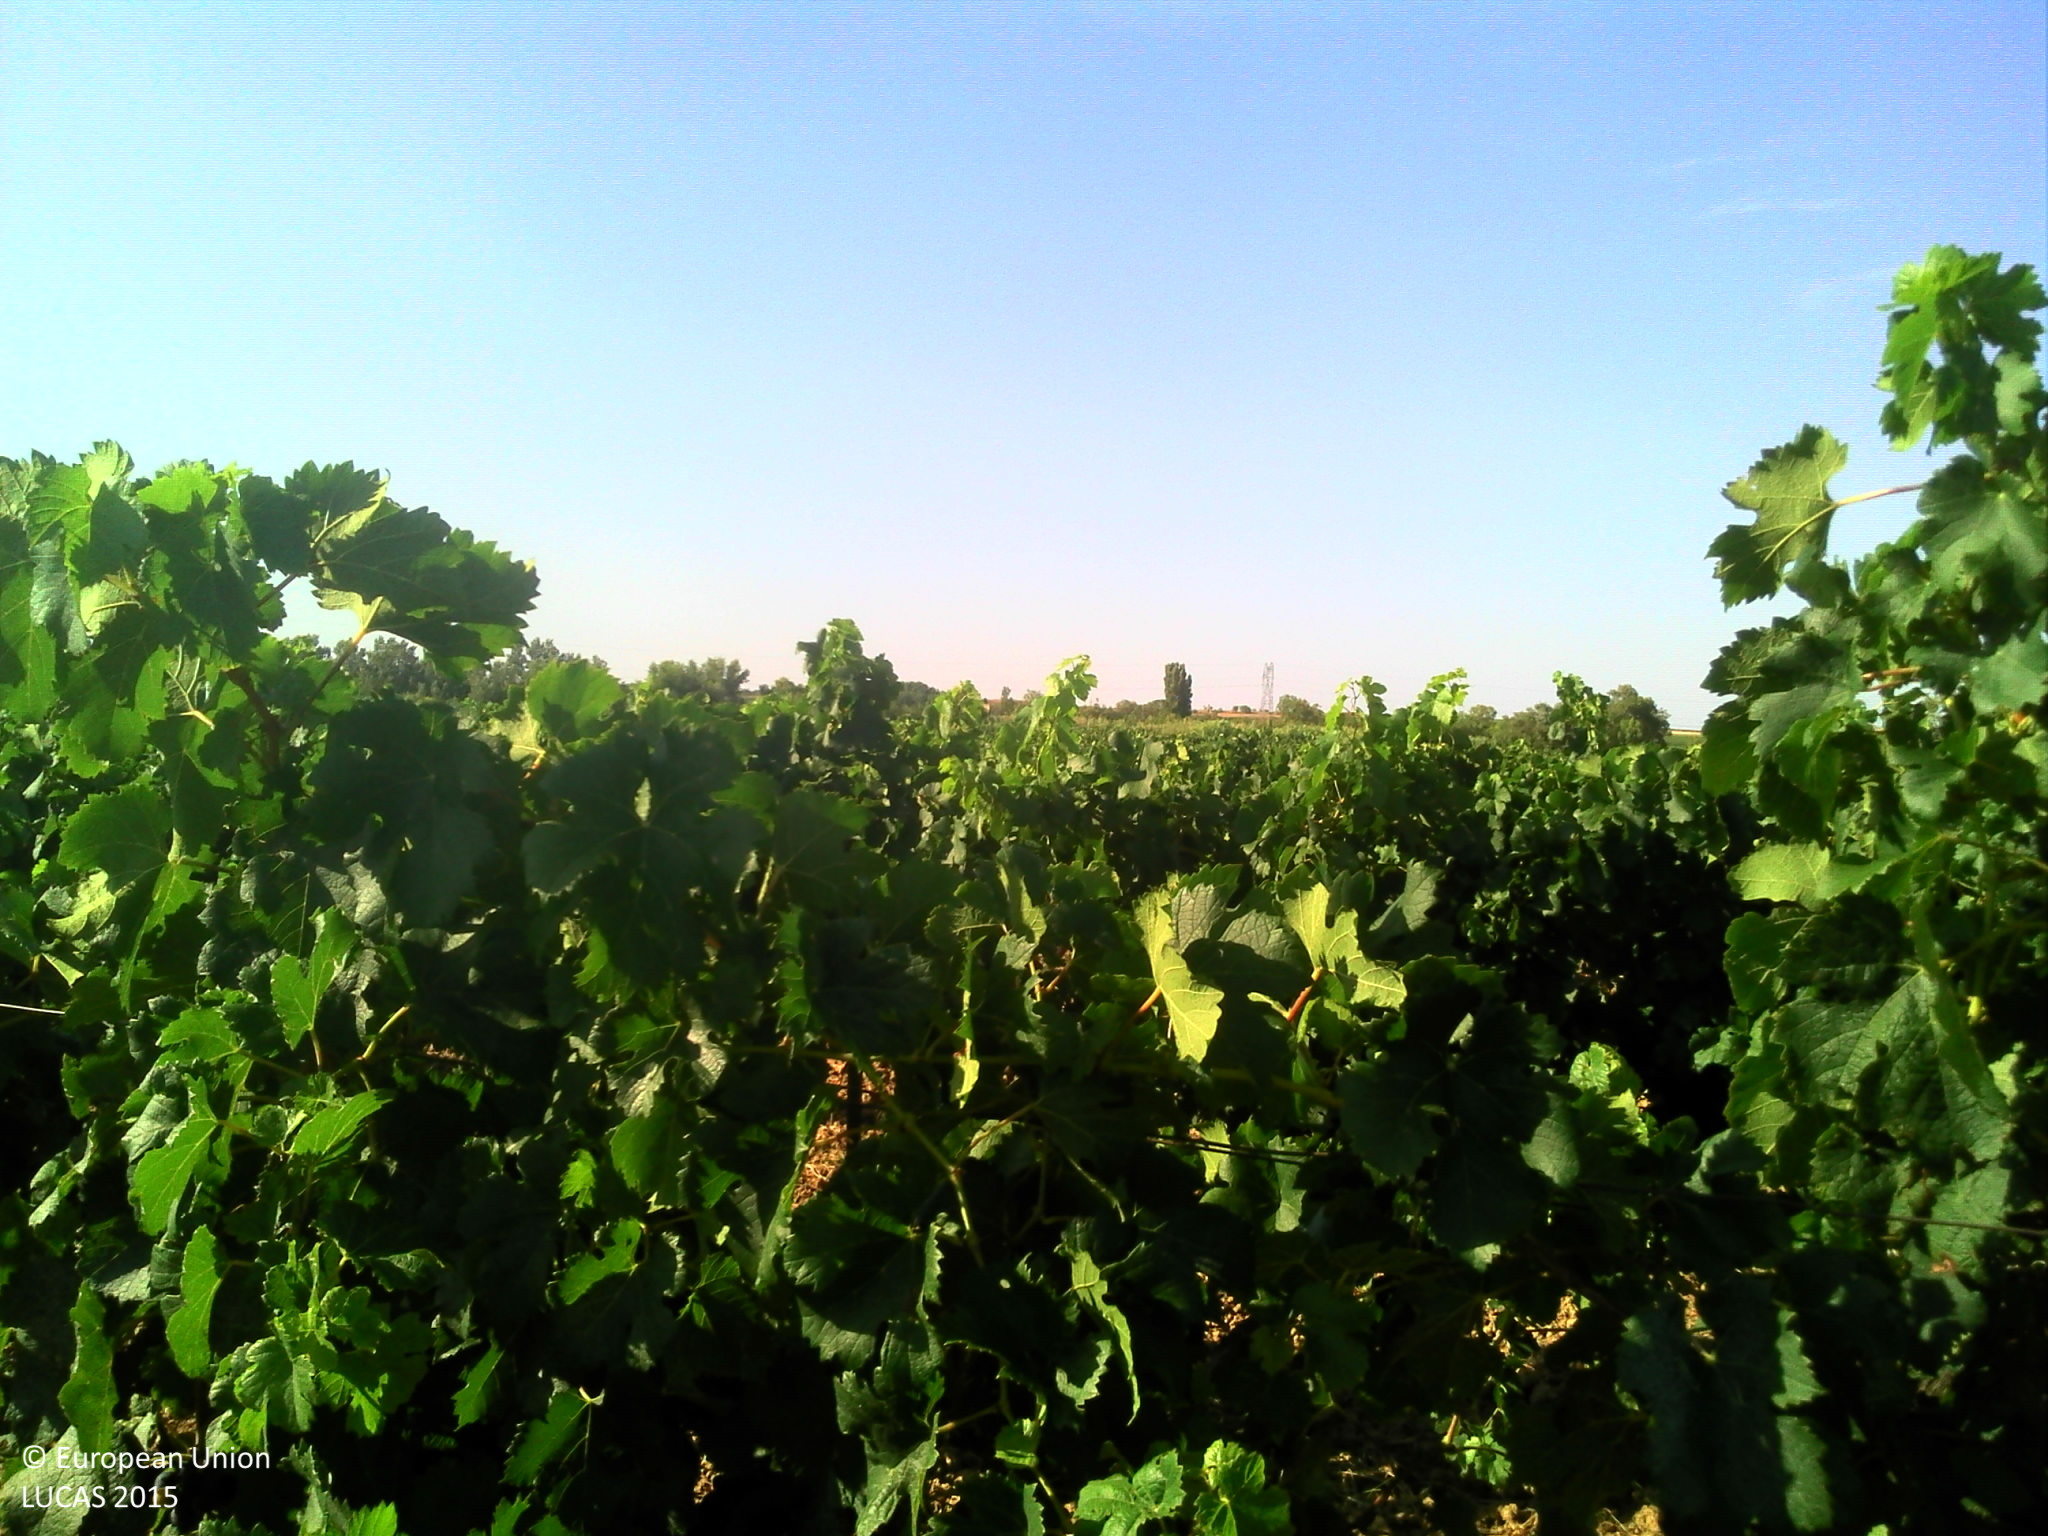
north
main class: Cropland
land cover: Vineyards
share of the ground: 25 - 50 %
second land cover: Other bare soil
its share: > 75 %
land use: Agriculture (excluding fallow land and kitchen gardens)
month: August
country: FR
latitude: 43.3971
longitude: 3.3794
